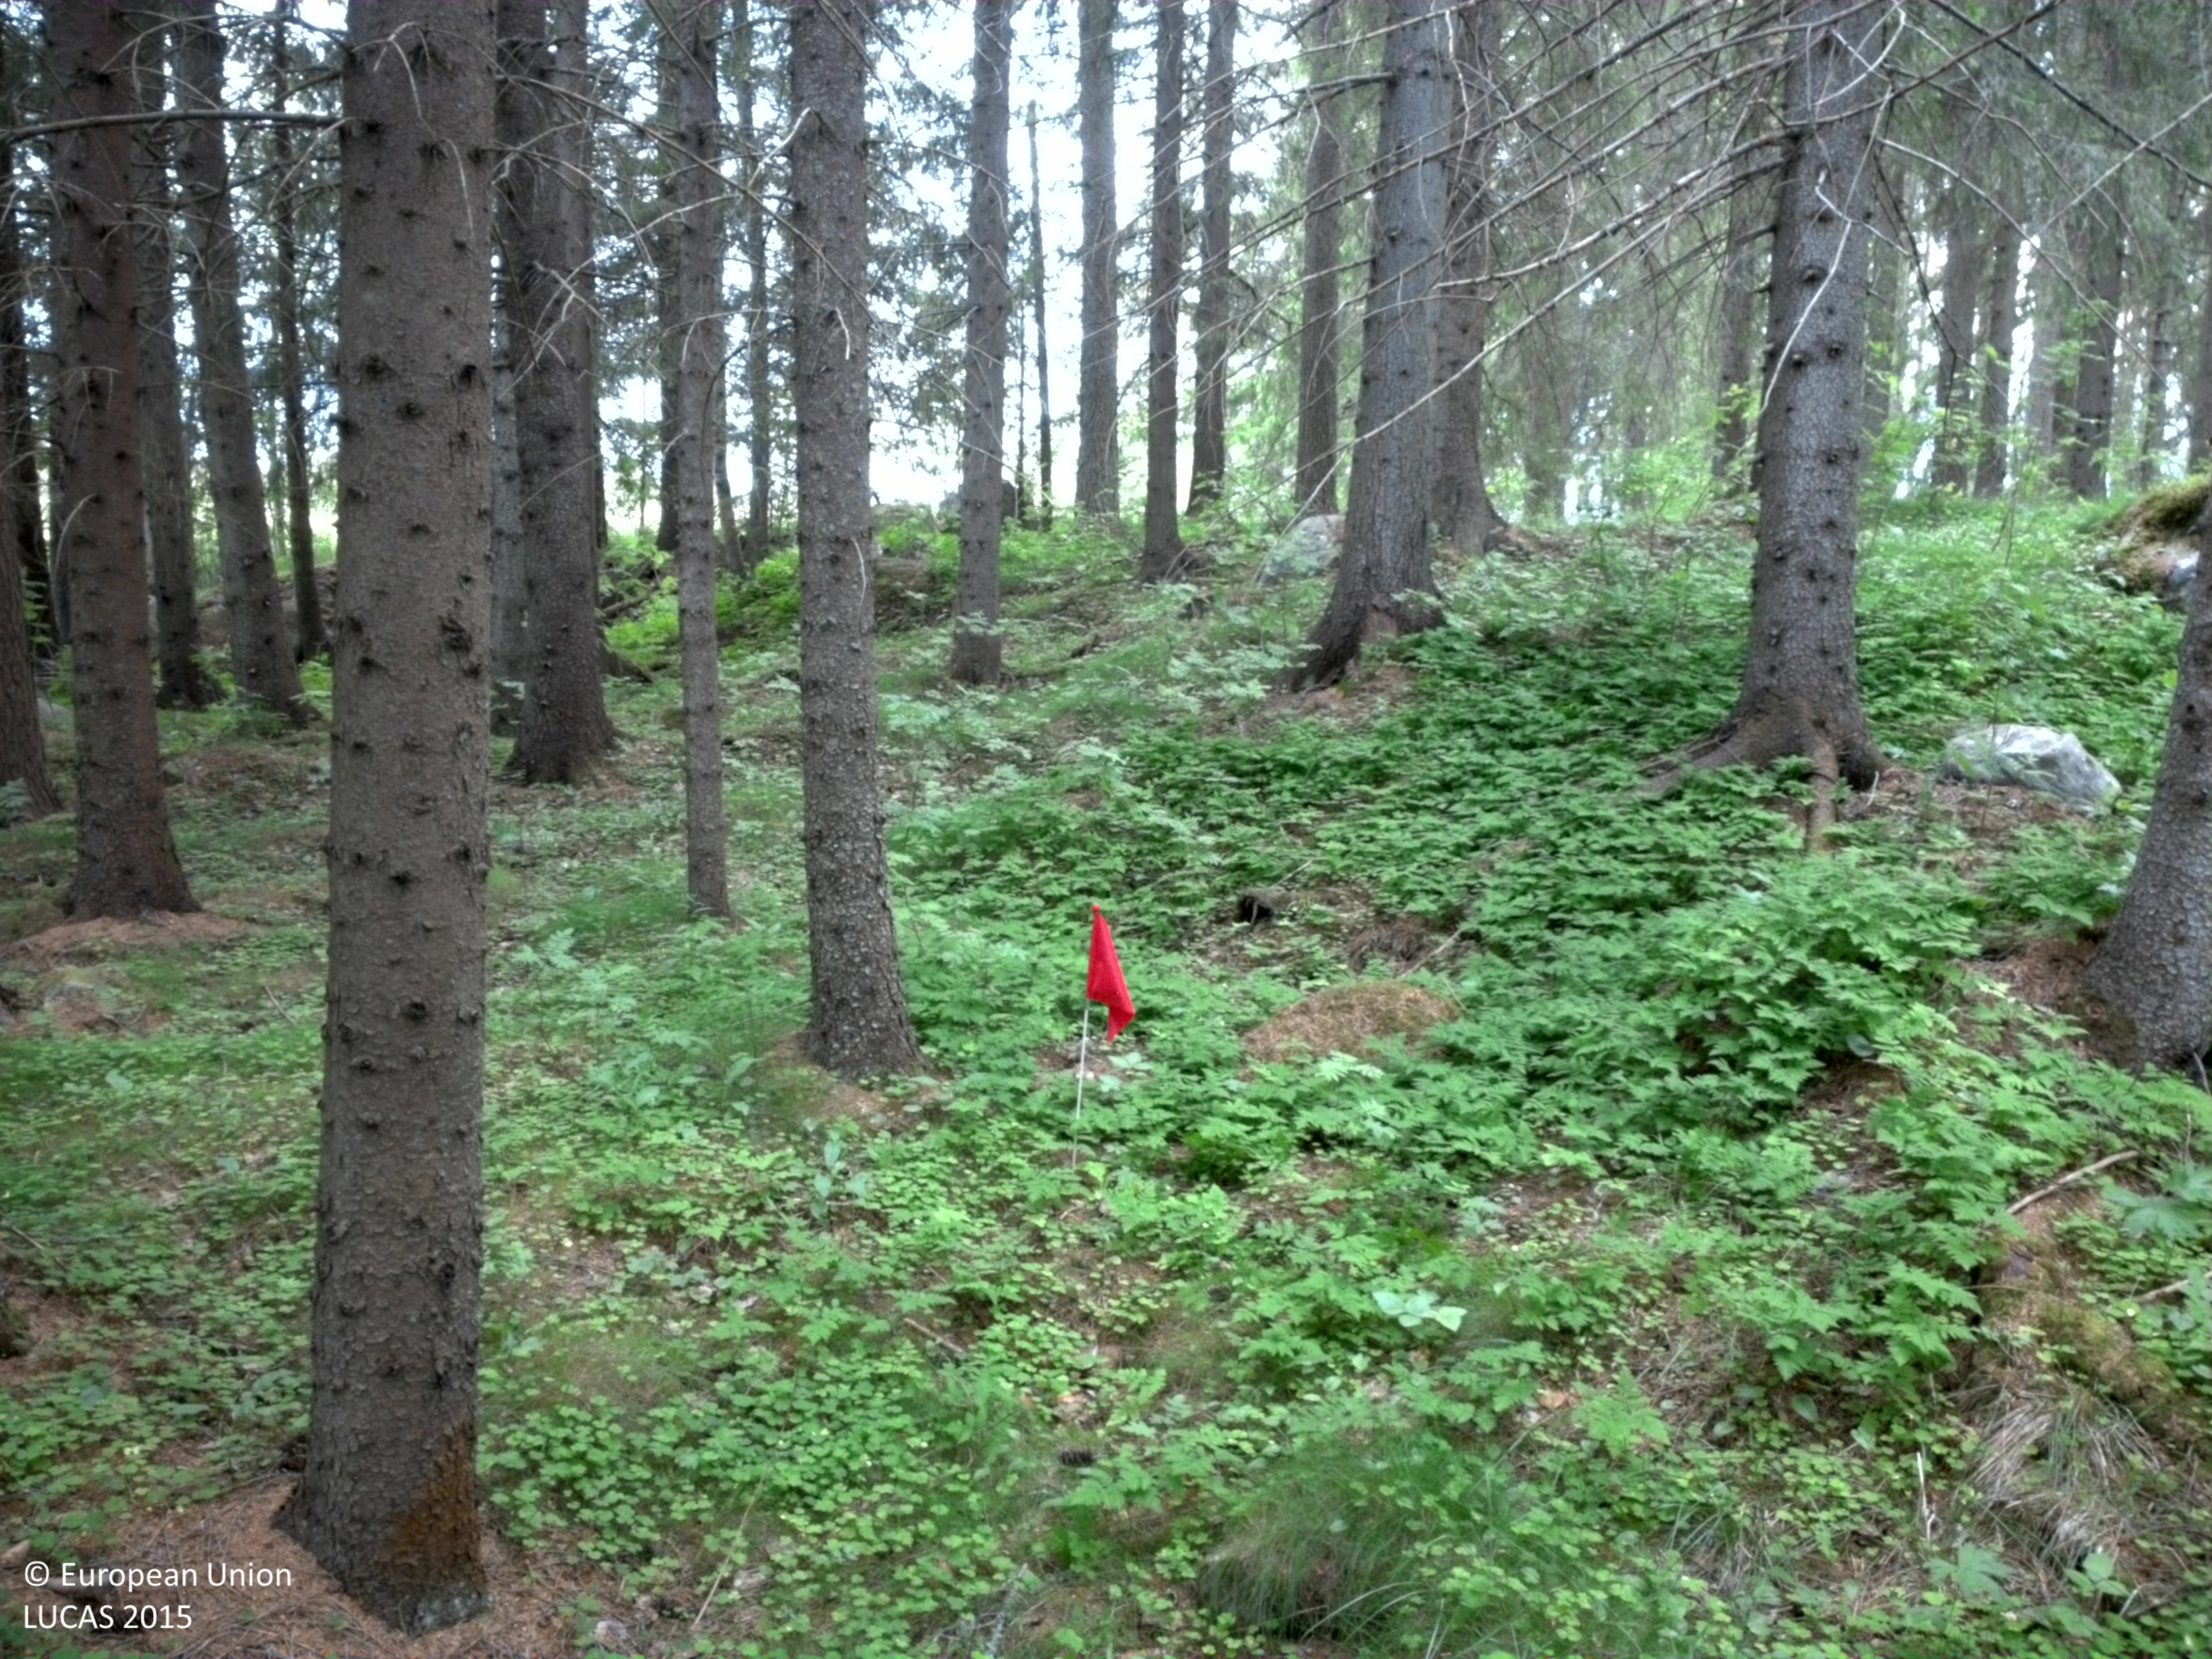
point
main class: Woodland
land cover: Spruce dominated coniferous woodland
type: boreal forest
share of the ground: > 75 %
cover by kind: coniferous forest trees 80 %, herbaceous plants 20 %
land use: Forestry
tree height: > 5 m
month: July
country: SE
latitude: 64.5112
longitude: 20.9563
